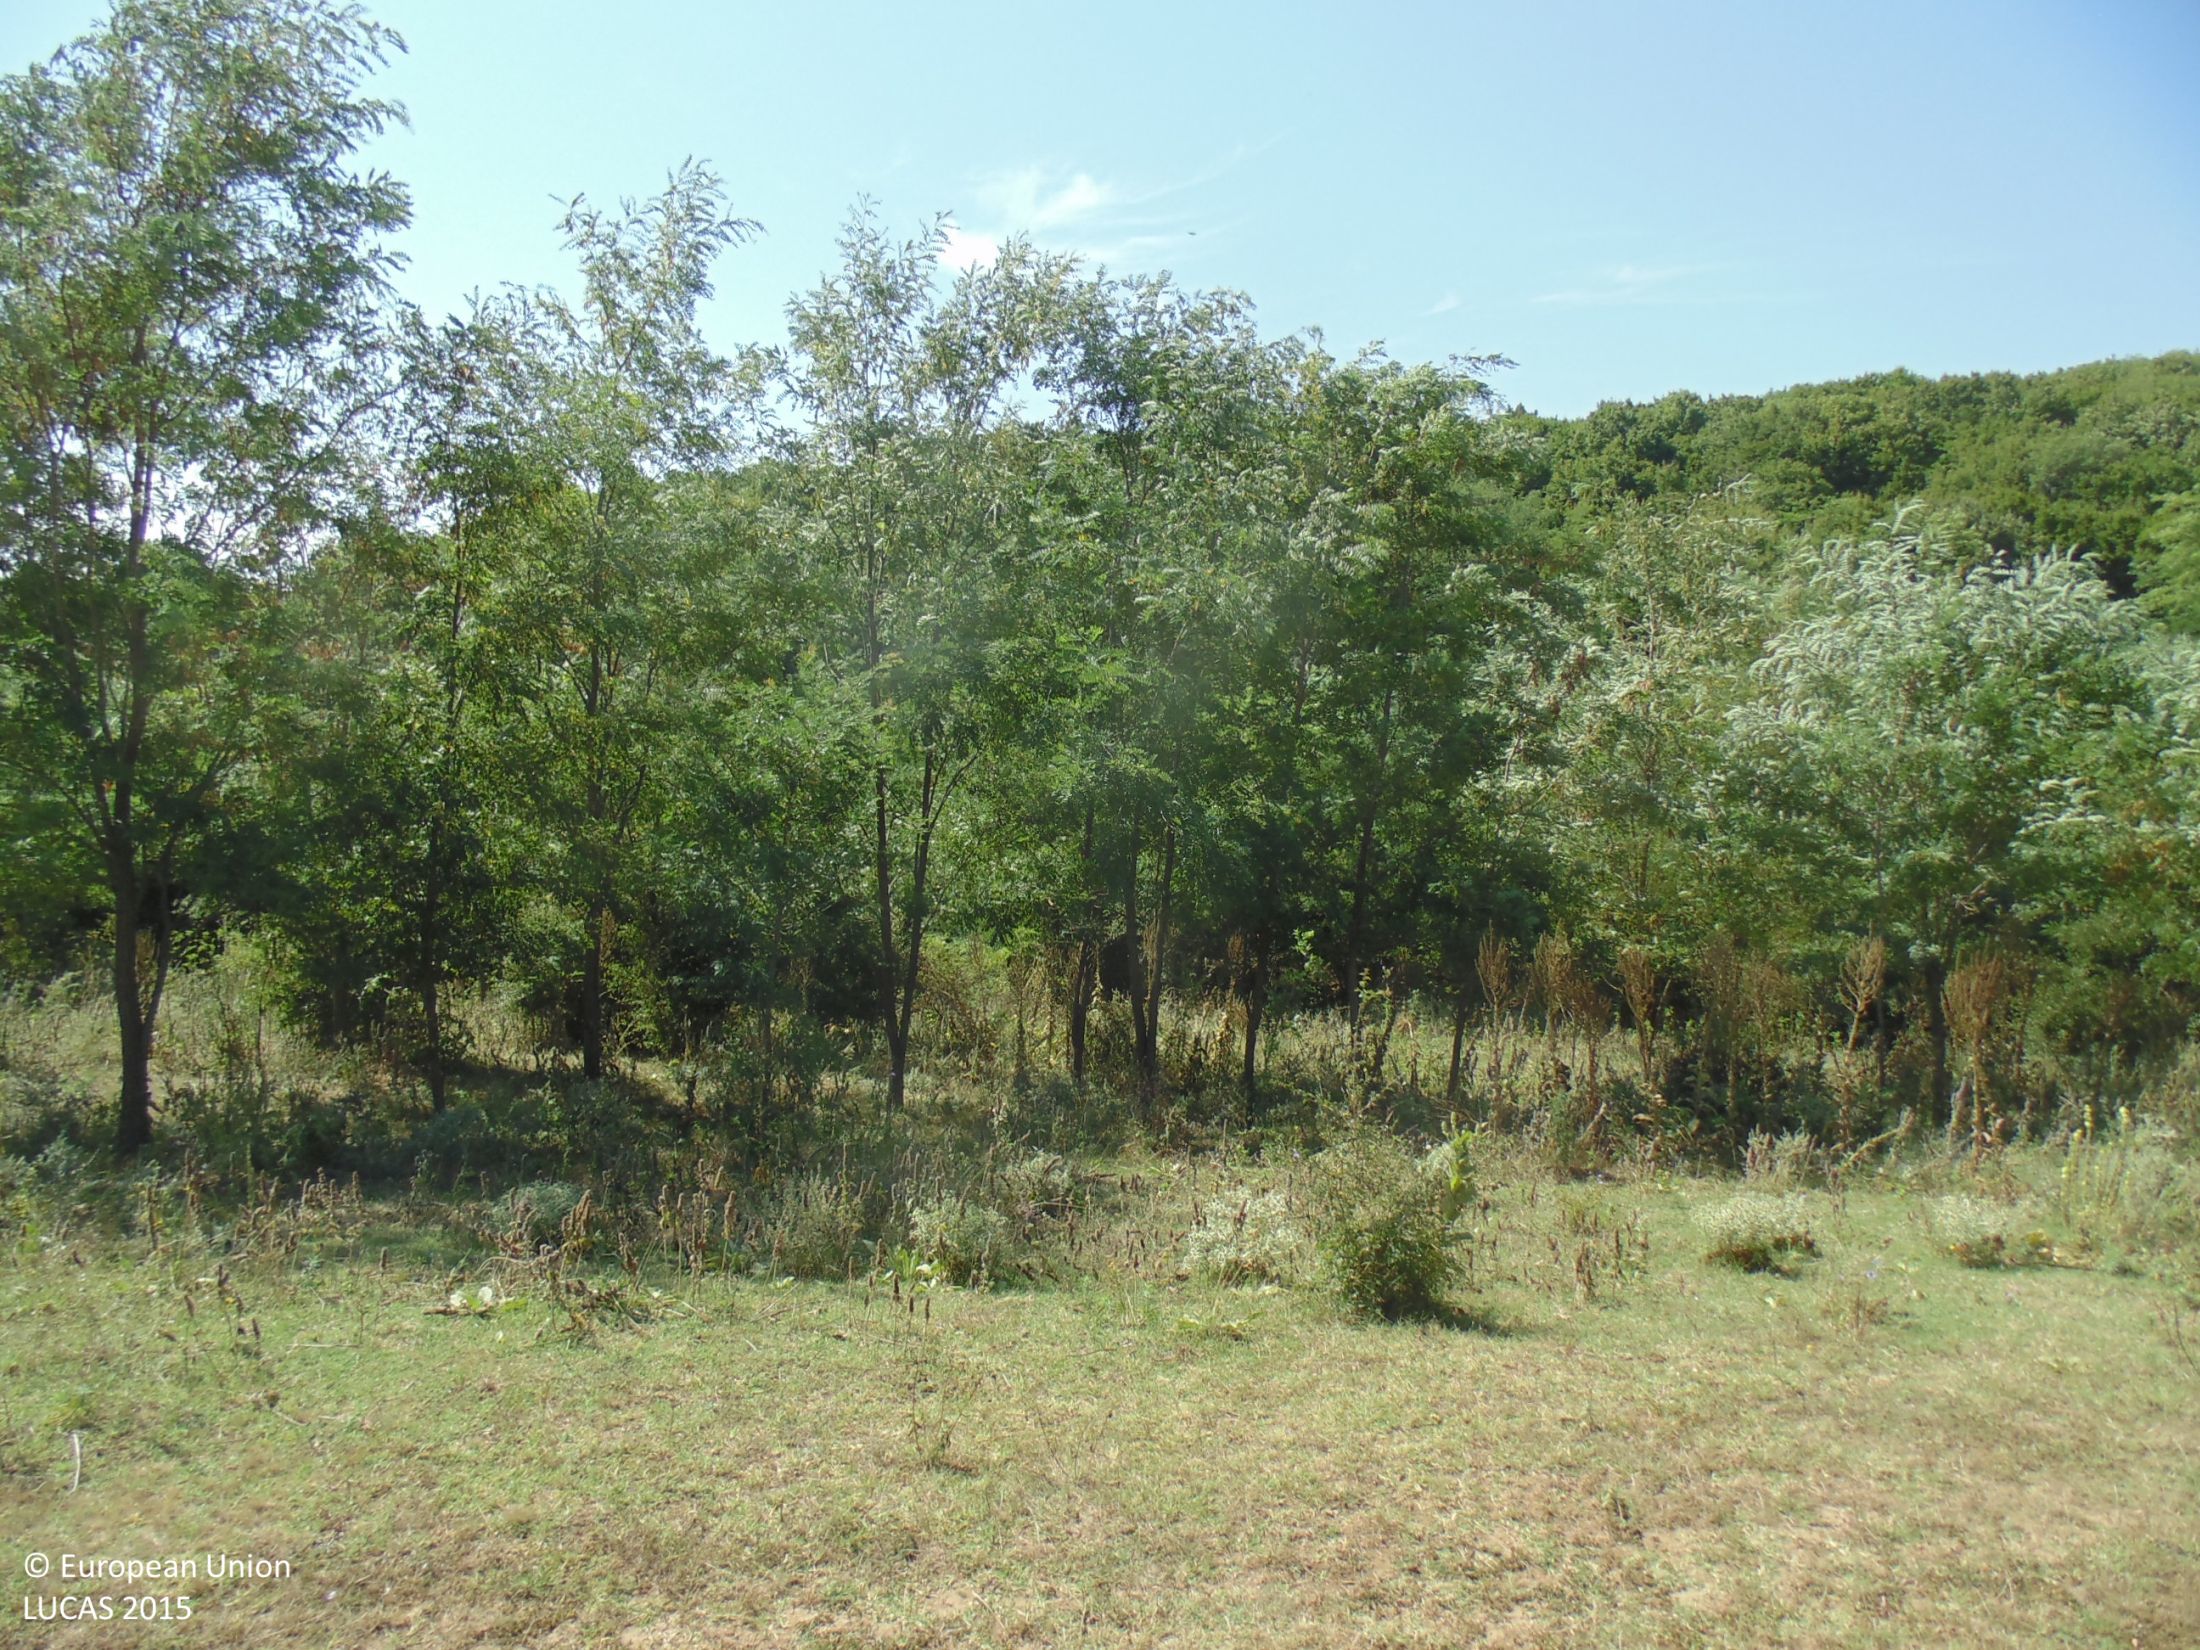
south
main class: Grassland
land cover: Grassland without tree/shrub cover
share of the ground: > 75 %
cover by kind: herbaceous plants 100 %
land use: Agriculture (excluding fallow land and kitchen gardens)
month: August
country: BG
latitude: 43.6397
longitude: 28.2406
